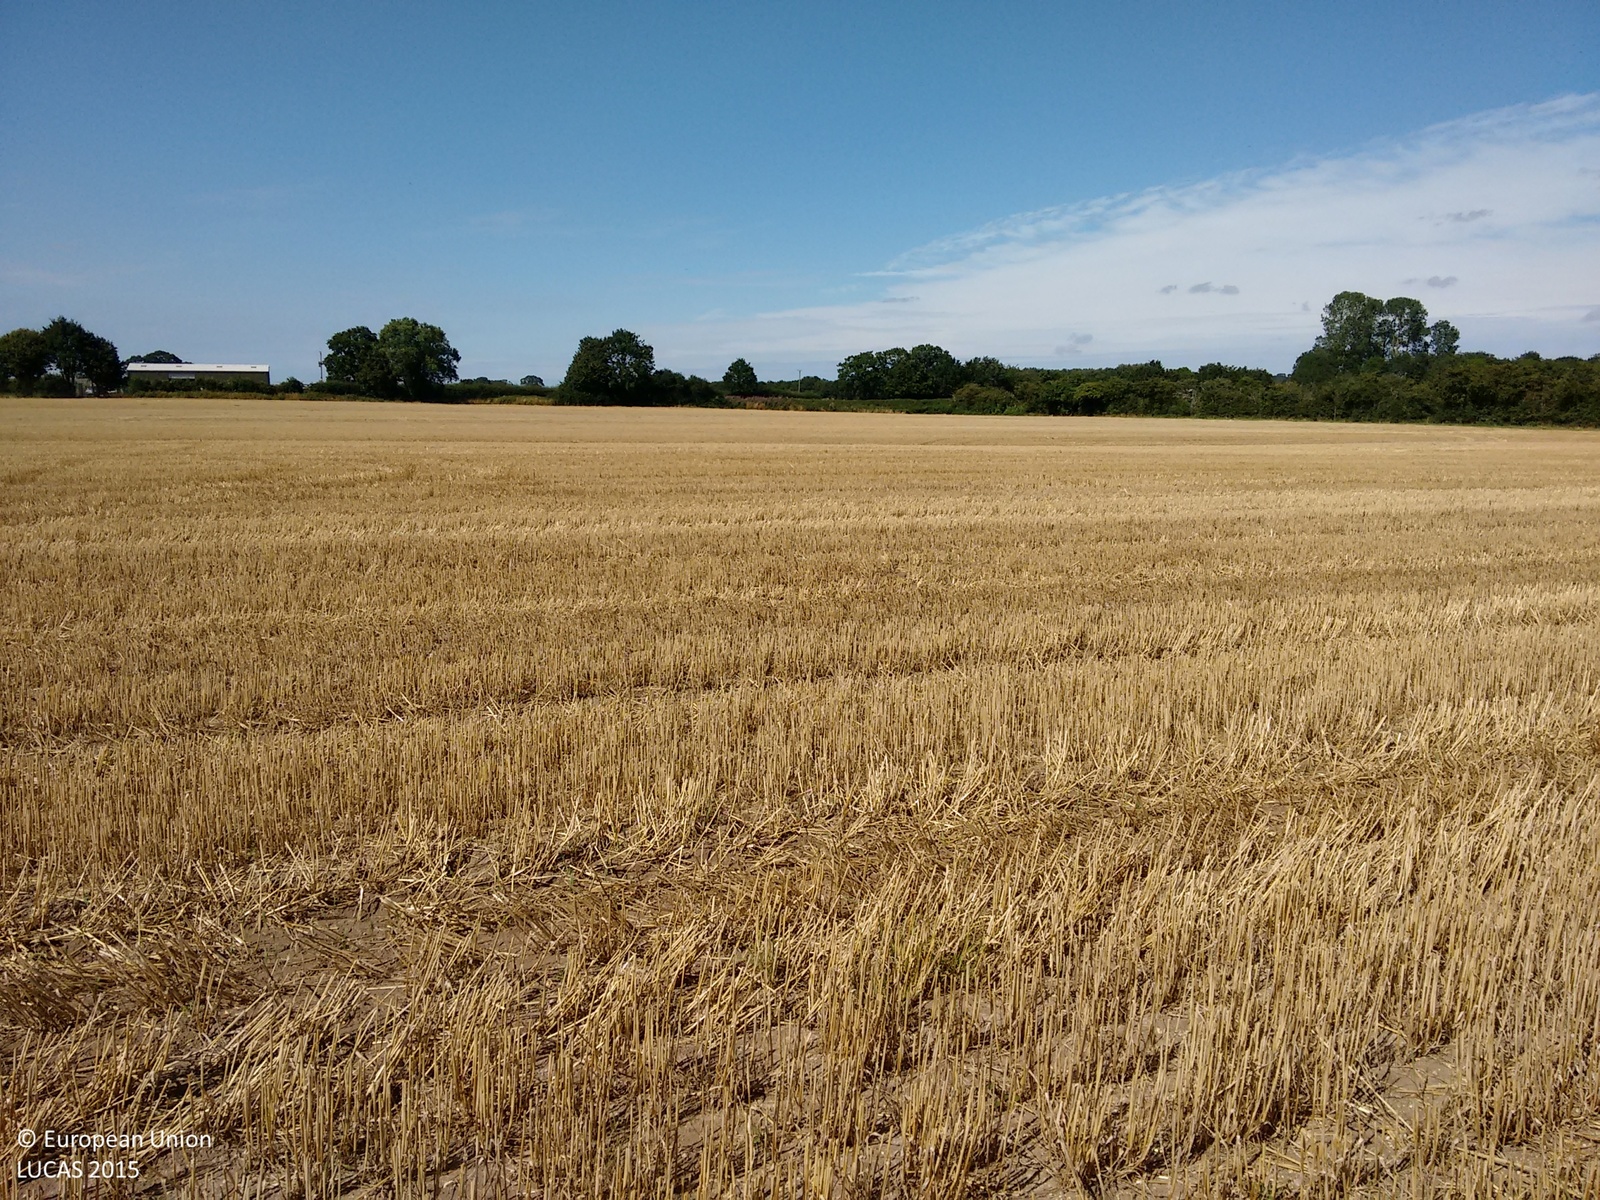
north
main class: Cropland
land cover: Common wheat
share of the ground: > 75 %
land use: Agriculture (excluding fallow land and kitchen gardens)
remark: Harvested field
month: August
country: GB
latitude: 52.7261
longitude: 0.8099
